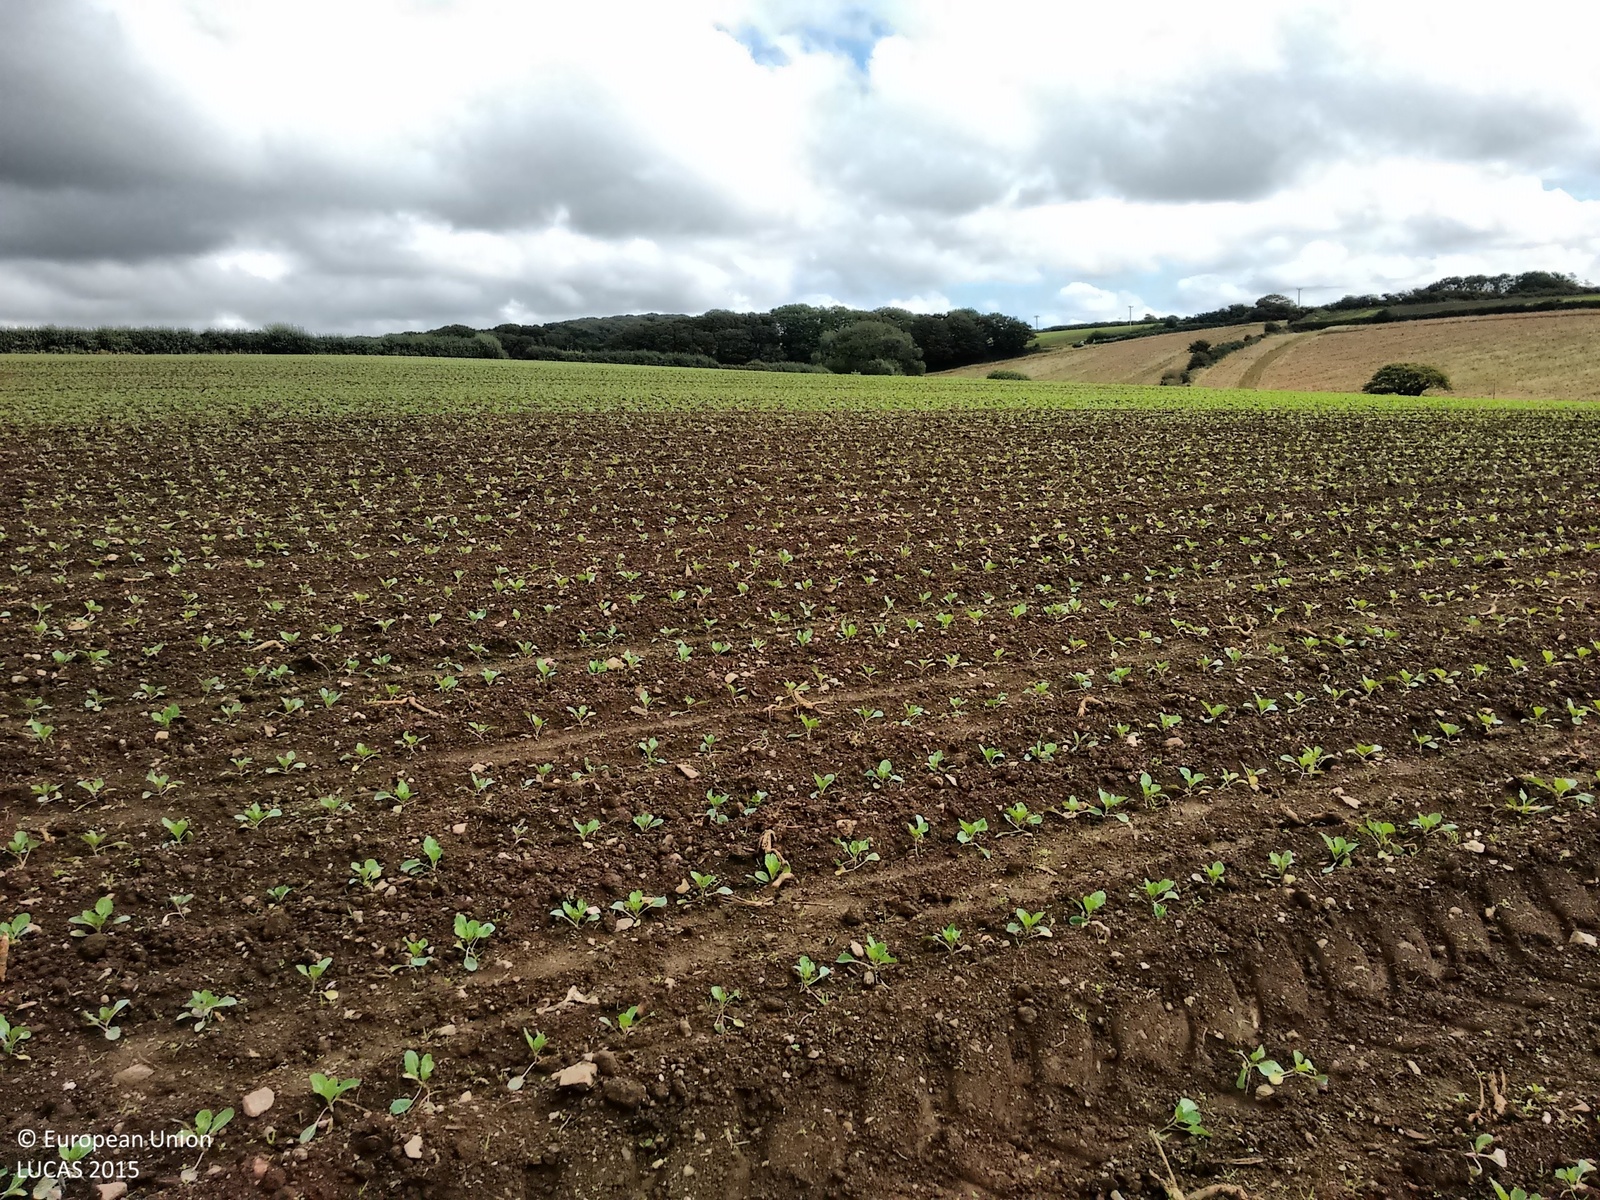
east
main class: Cropland
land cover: Other fresh vegetables
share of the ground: < 10 %
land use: Agriculture (excluding fallow land and kitchen gardens)
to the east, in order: Other fresh vegetables; Other bare soil; Fences; Grass margins; Abandoned hedges; Artificial constructions; Spontaneously vegetated surfaces
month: September
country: GB
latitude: 50.1319
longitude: -5.3012
